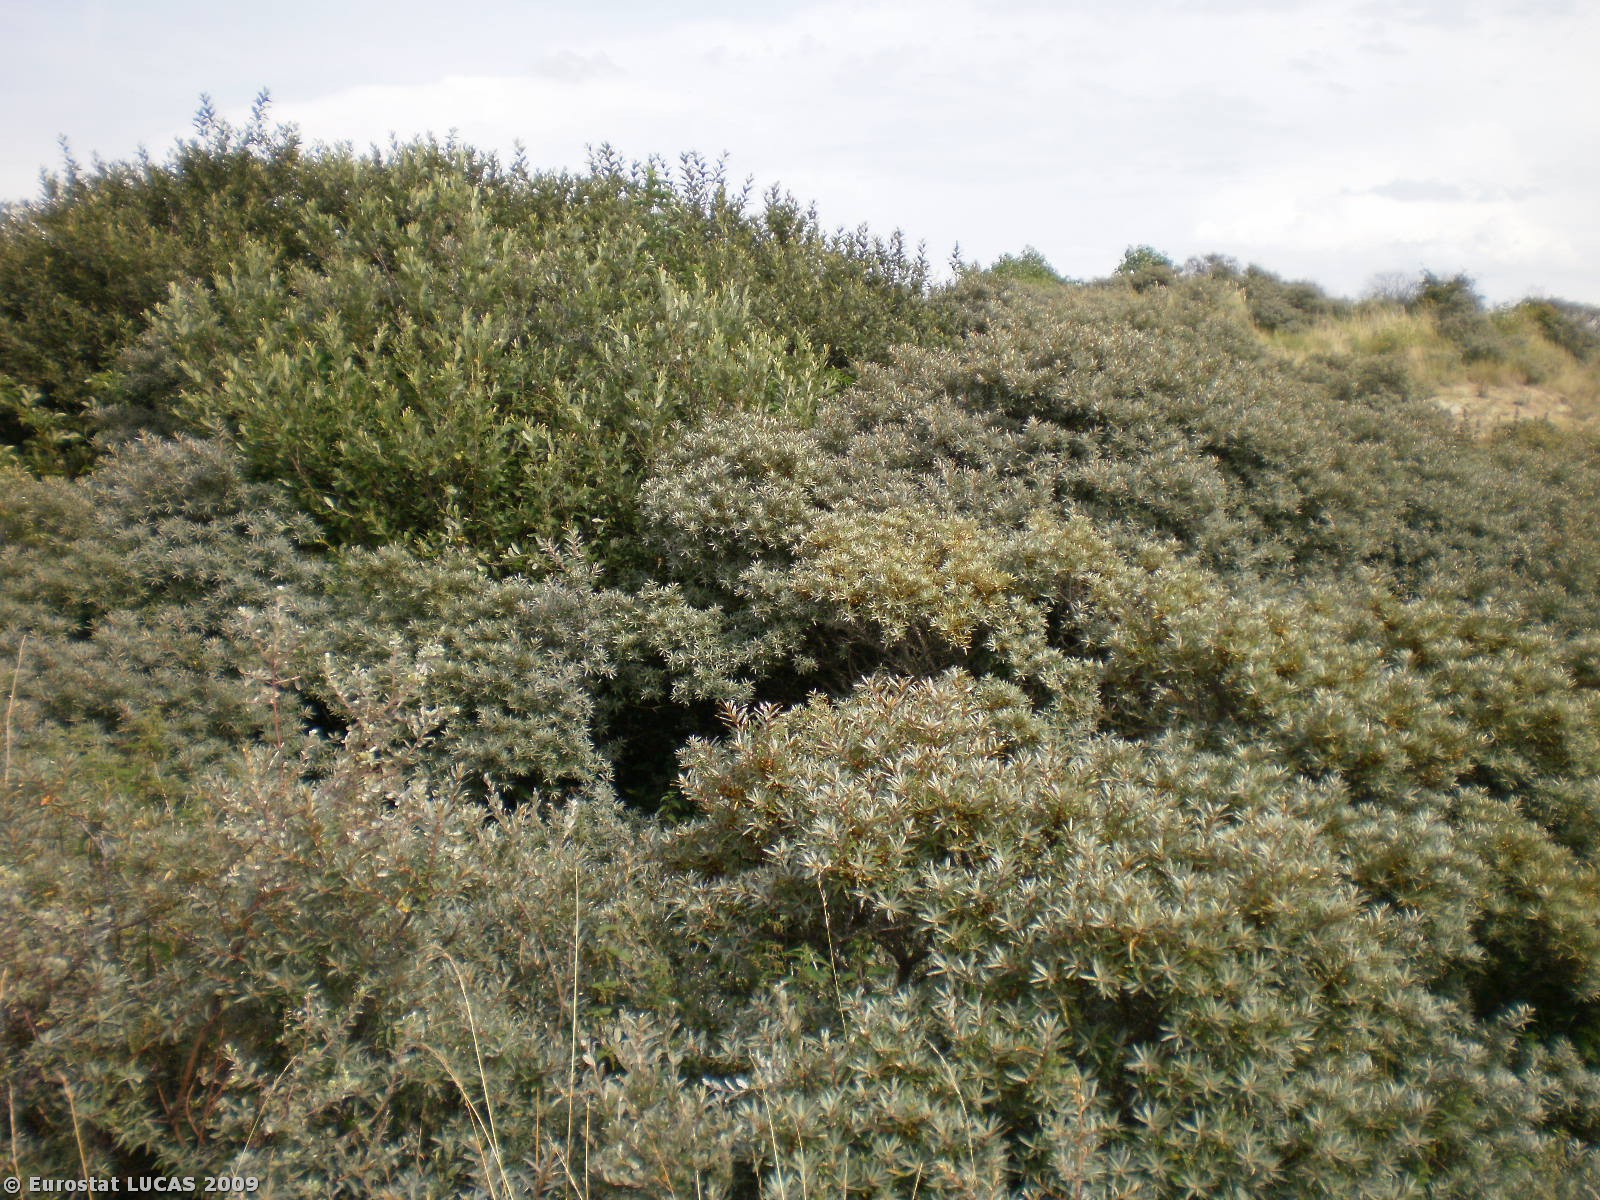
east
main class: Shrubland
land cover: Shrubland with sparse tree cover
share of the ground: 25 - 50 %
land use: Nature reserves
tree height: < 5 m
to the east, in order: Shrubland with sparse tree cover; Grass margins; Paved roads, cycling and walking lanes; Grass margins; Artificial constructions in urban areas; Grassland without tree/shrub cover
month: July
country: BE
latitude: 51.1640
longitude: 2.7670
